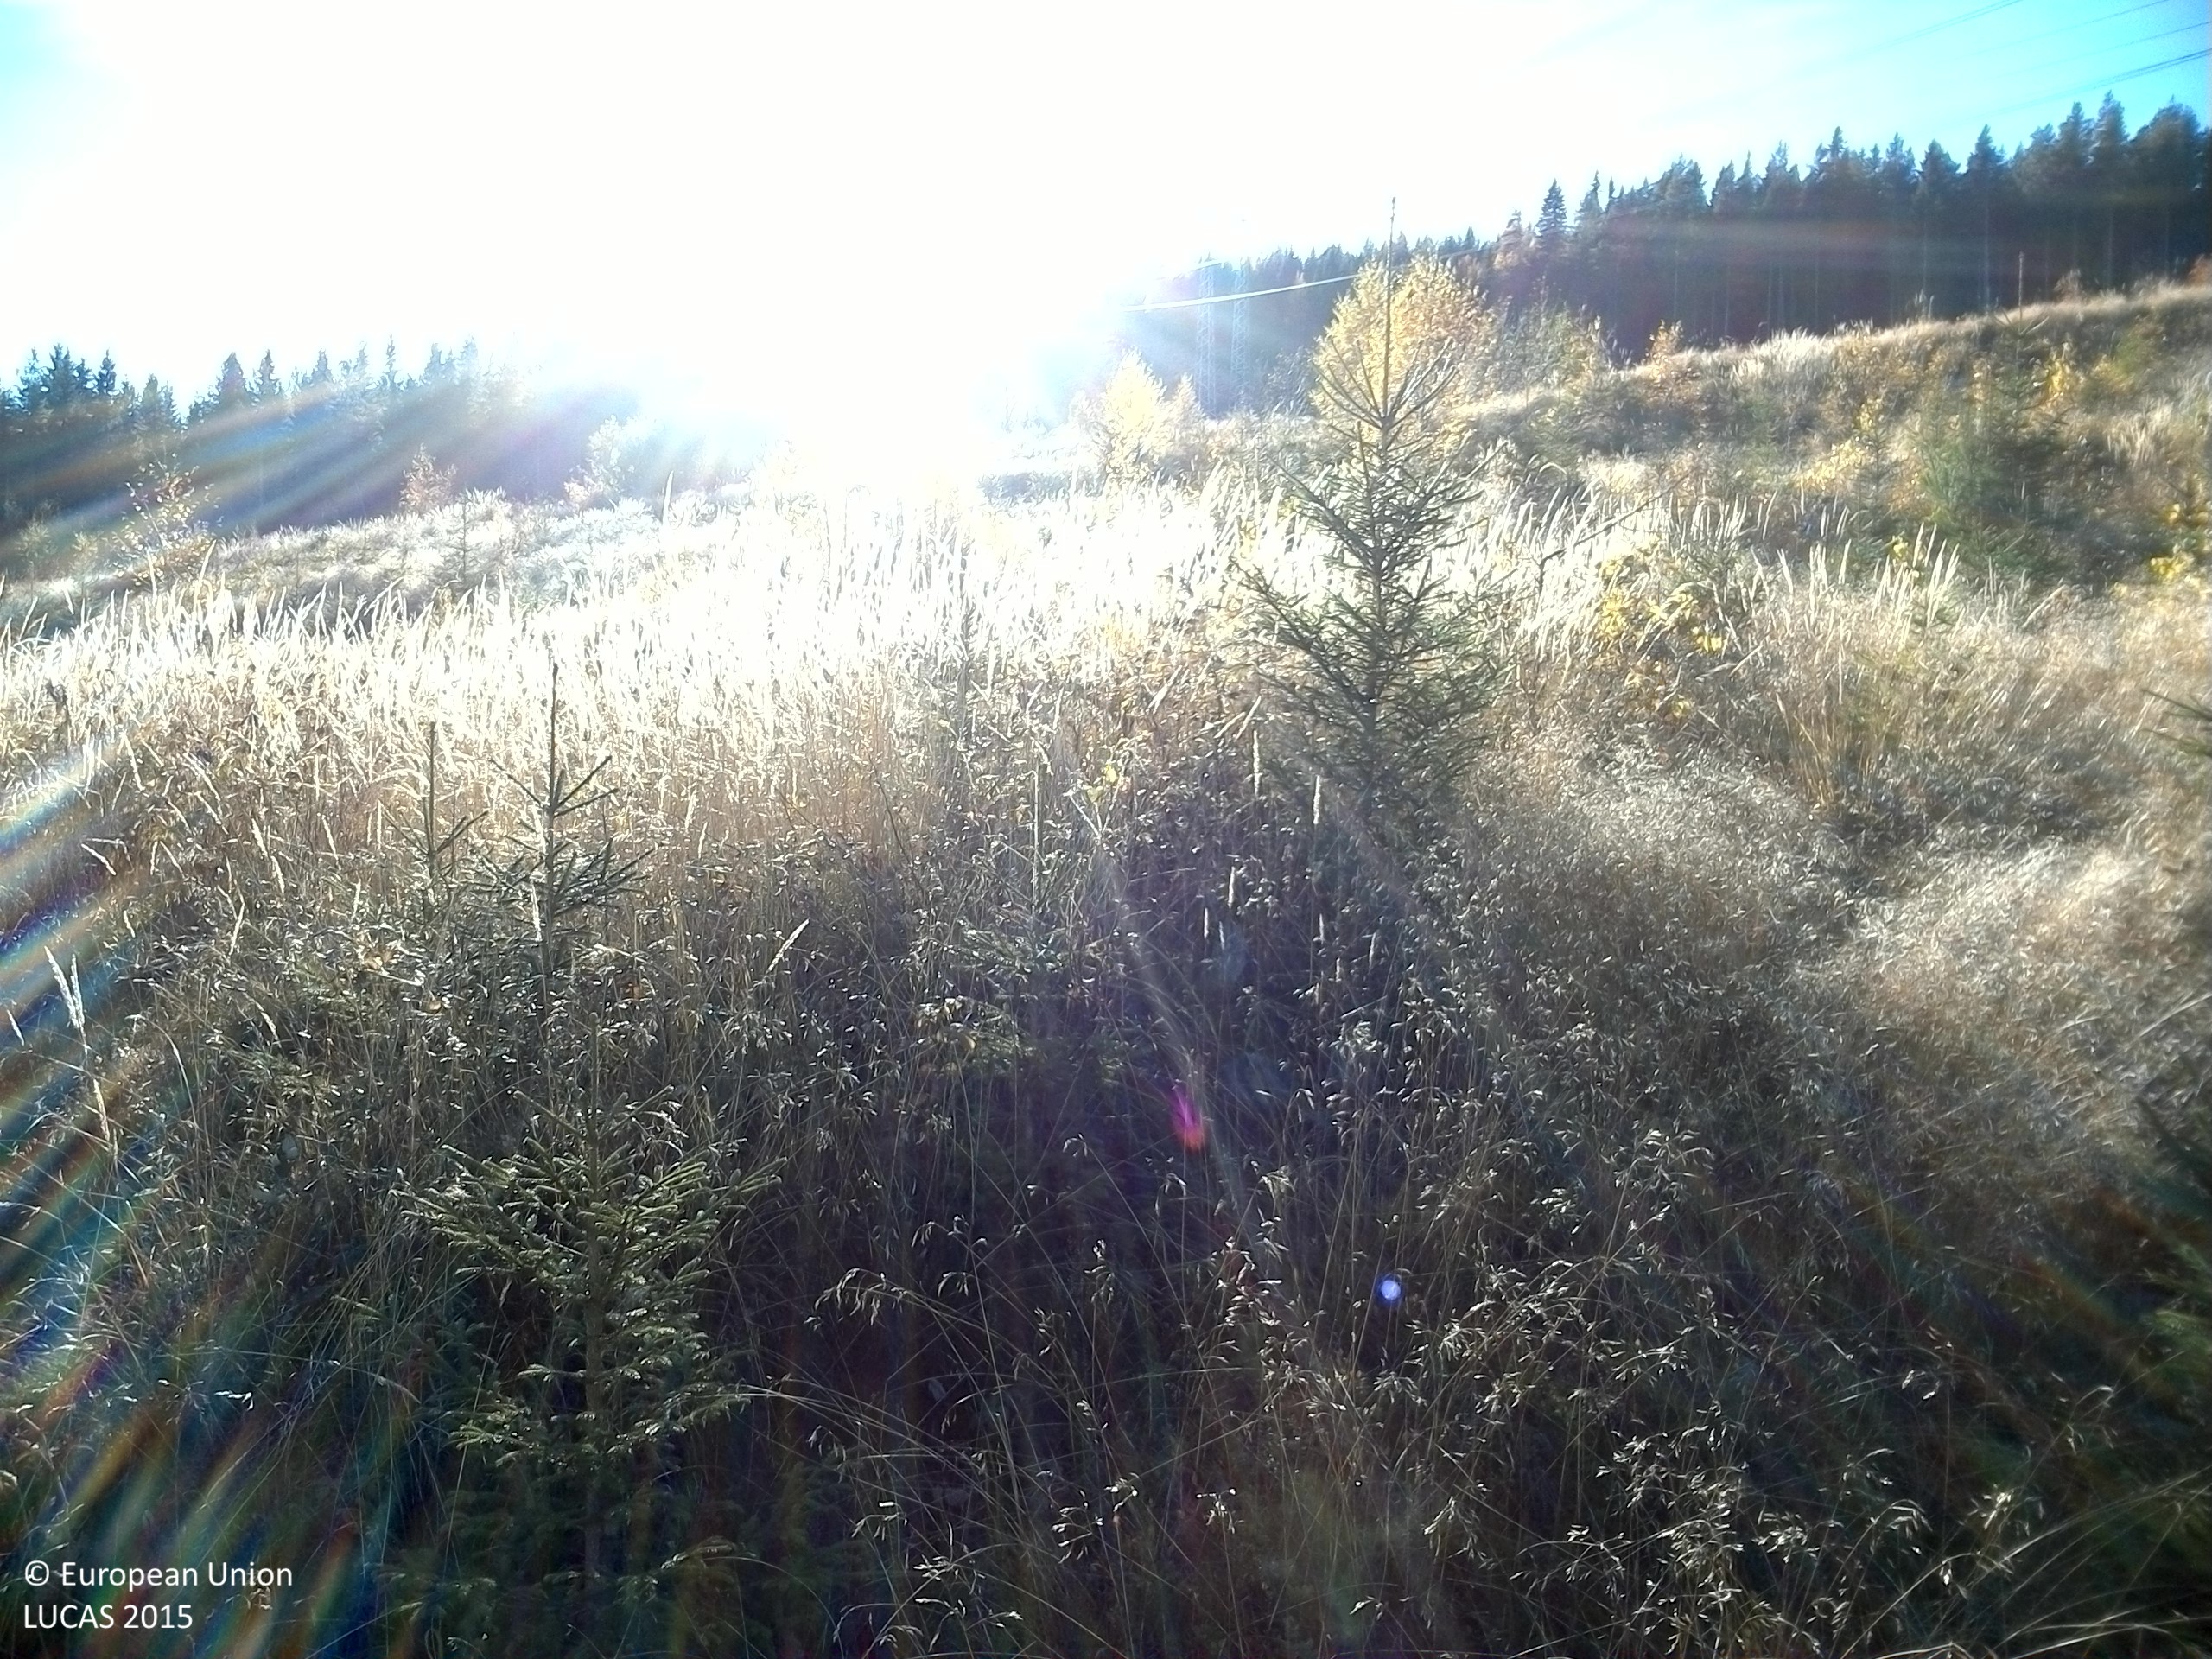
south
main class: Woodland
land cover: Spruce dominated mixed woodland
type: boreal forest
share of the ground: 25 - 50 %
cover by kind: coniferous forest trees 25 %, broadleaved forest trees 25 %, shrubs 25 %, herbaceous plants 25 %
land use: Forestry
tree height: < 5 m
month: October
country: SE
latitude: 61.1966
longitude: 14.3215
